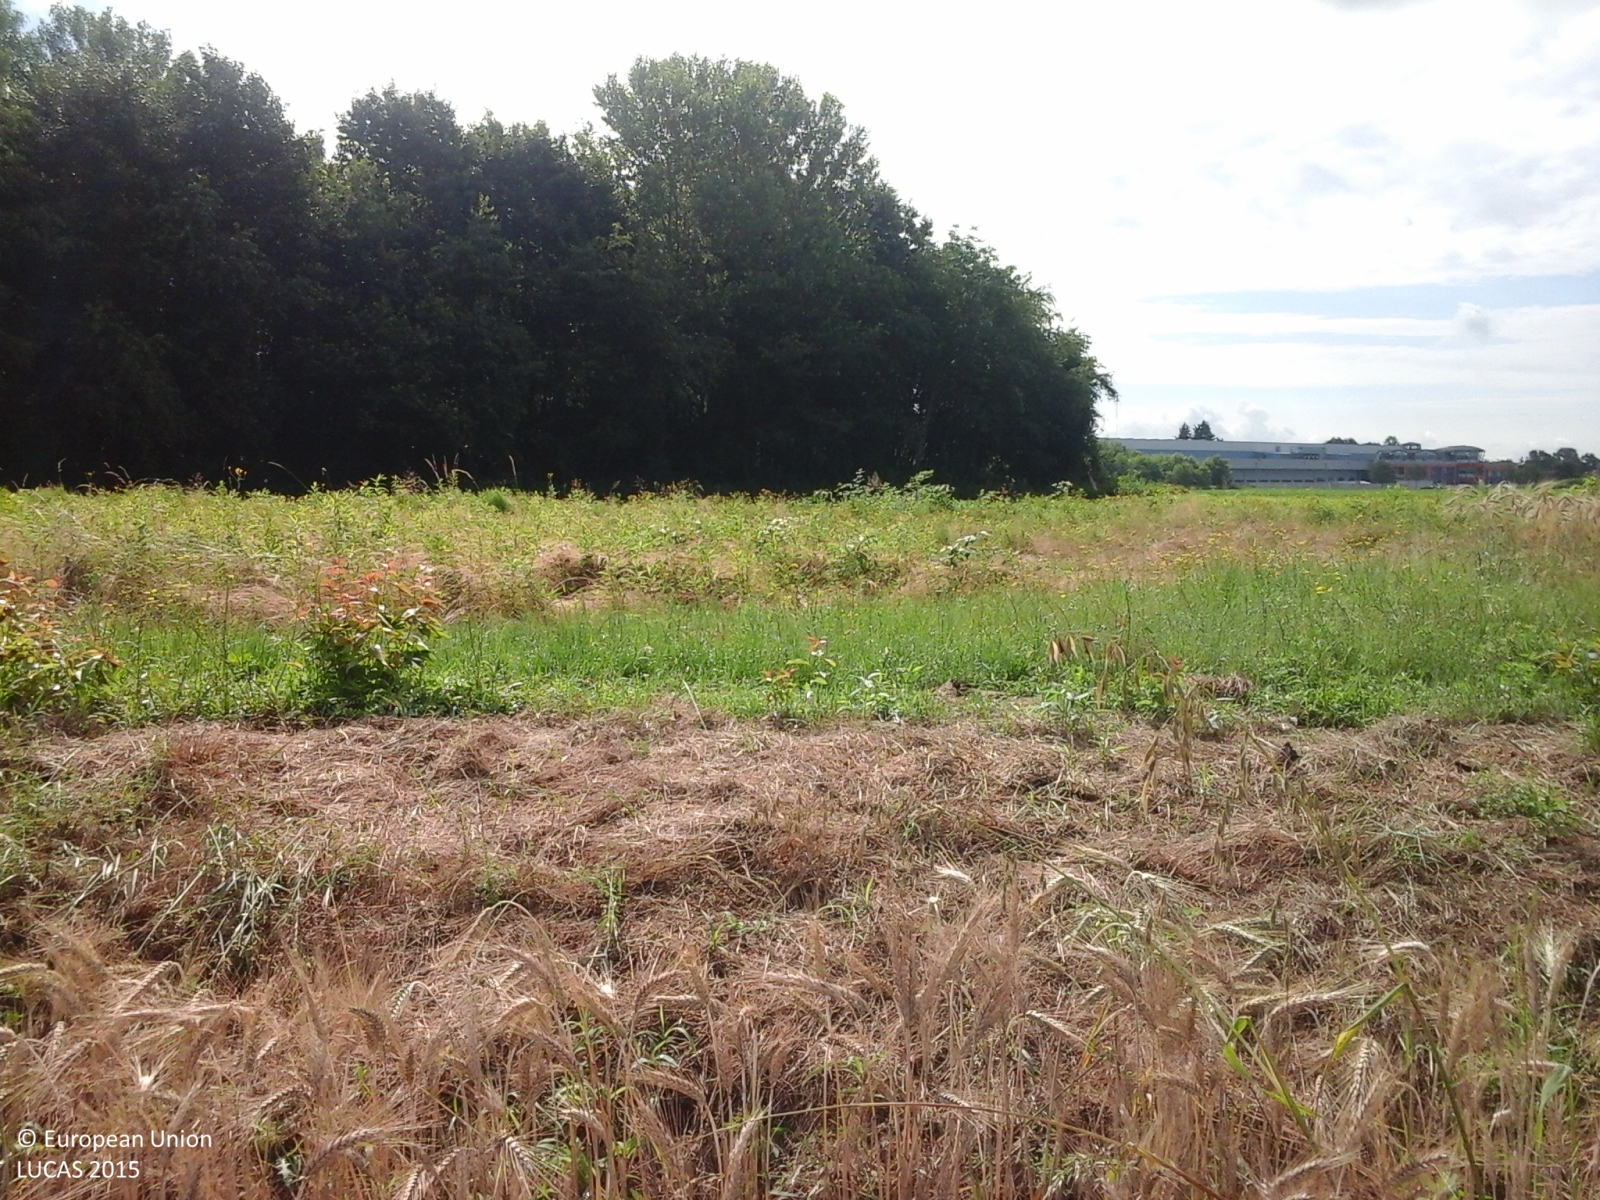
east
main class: Cropland
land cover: Triticale
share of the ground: > 75 %
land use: Agriculture (excluding fallow land and kitchen gardens)
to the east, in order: Triticale; Grass margins; Tracks; Spontaneously vegetated surfaces; Rice; Grass margins; Broadleaved woodland; Grass margins; Triticale; Temporary grasslands; Triticale
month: June
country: IT
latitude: 45.4965
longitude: 8.7097
